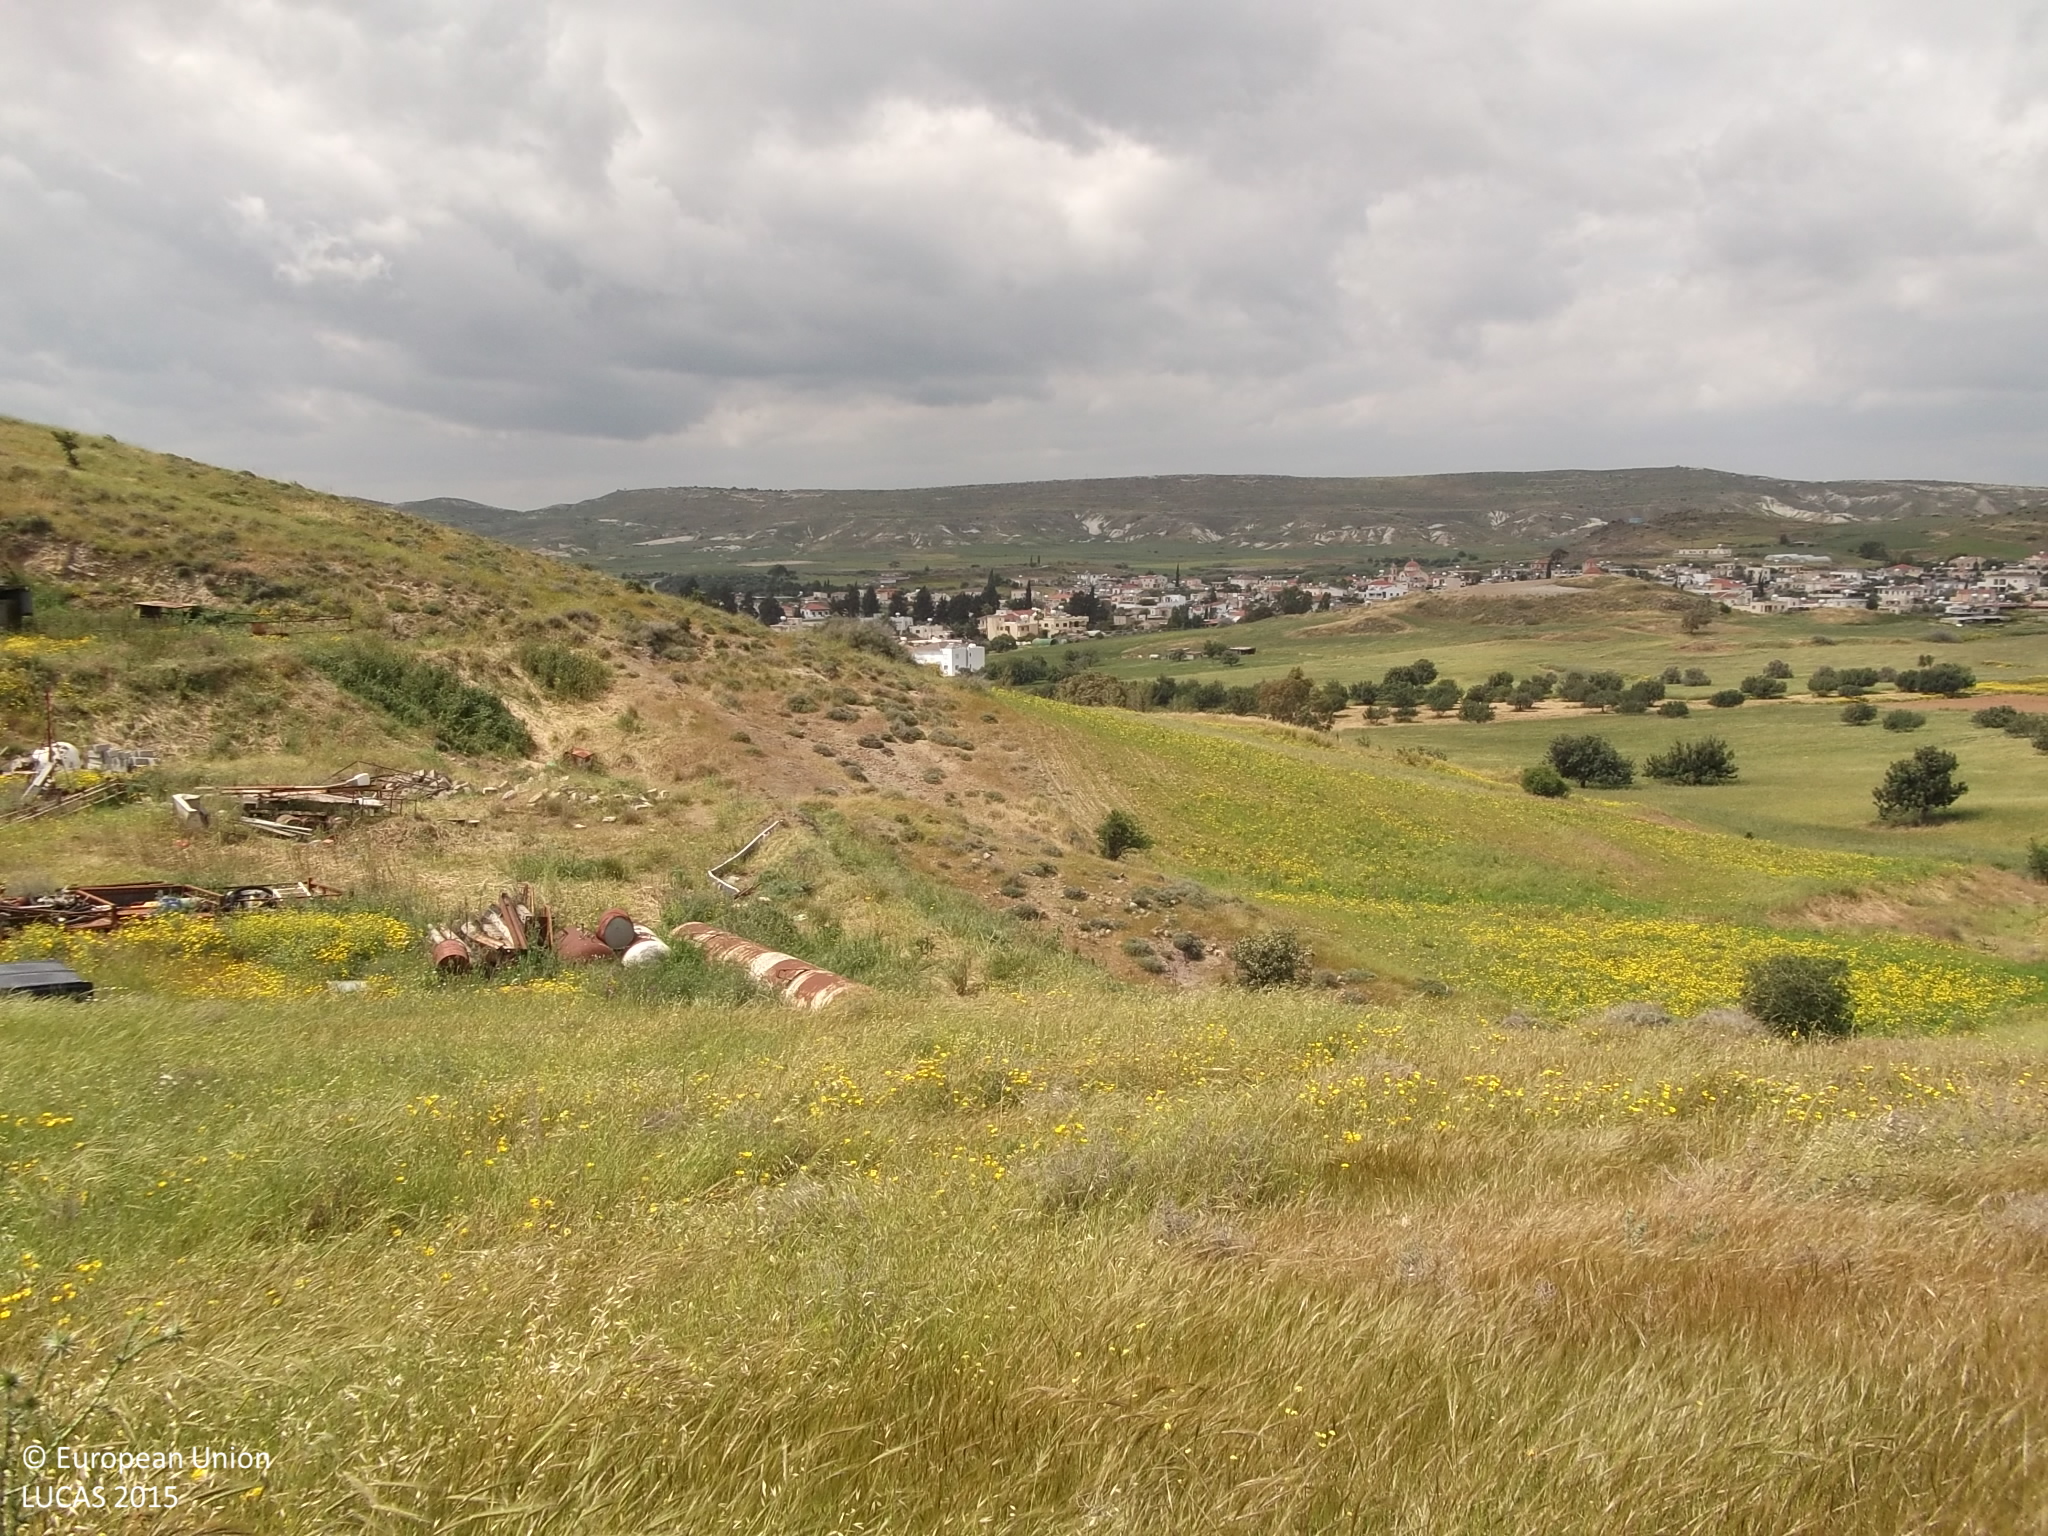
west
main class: Grassland
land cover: Grassland without tree/shrub cover
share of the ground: > 75 %
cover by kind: herbaceous plants 95 %, shrubs 5 %
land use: Semi-natural and natural areas not in use
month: April
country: CY
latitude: 35.0269
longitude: 33.6222
